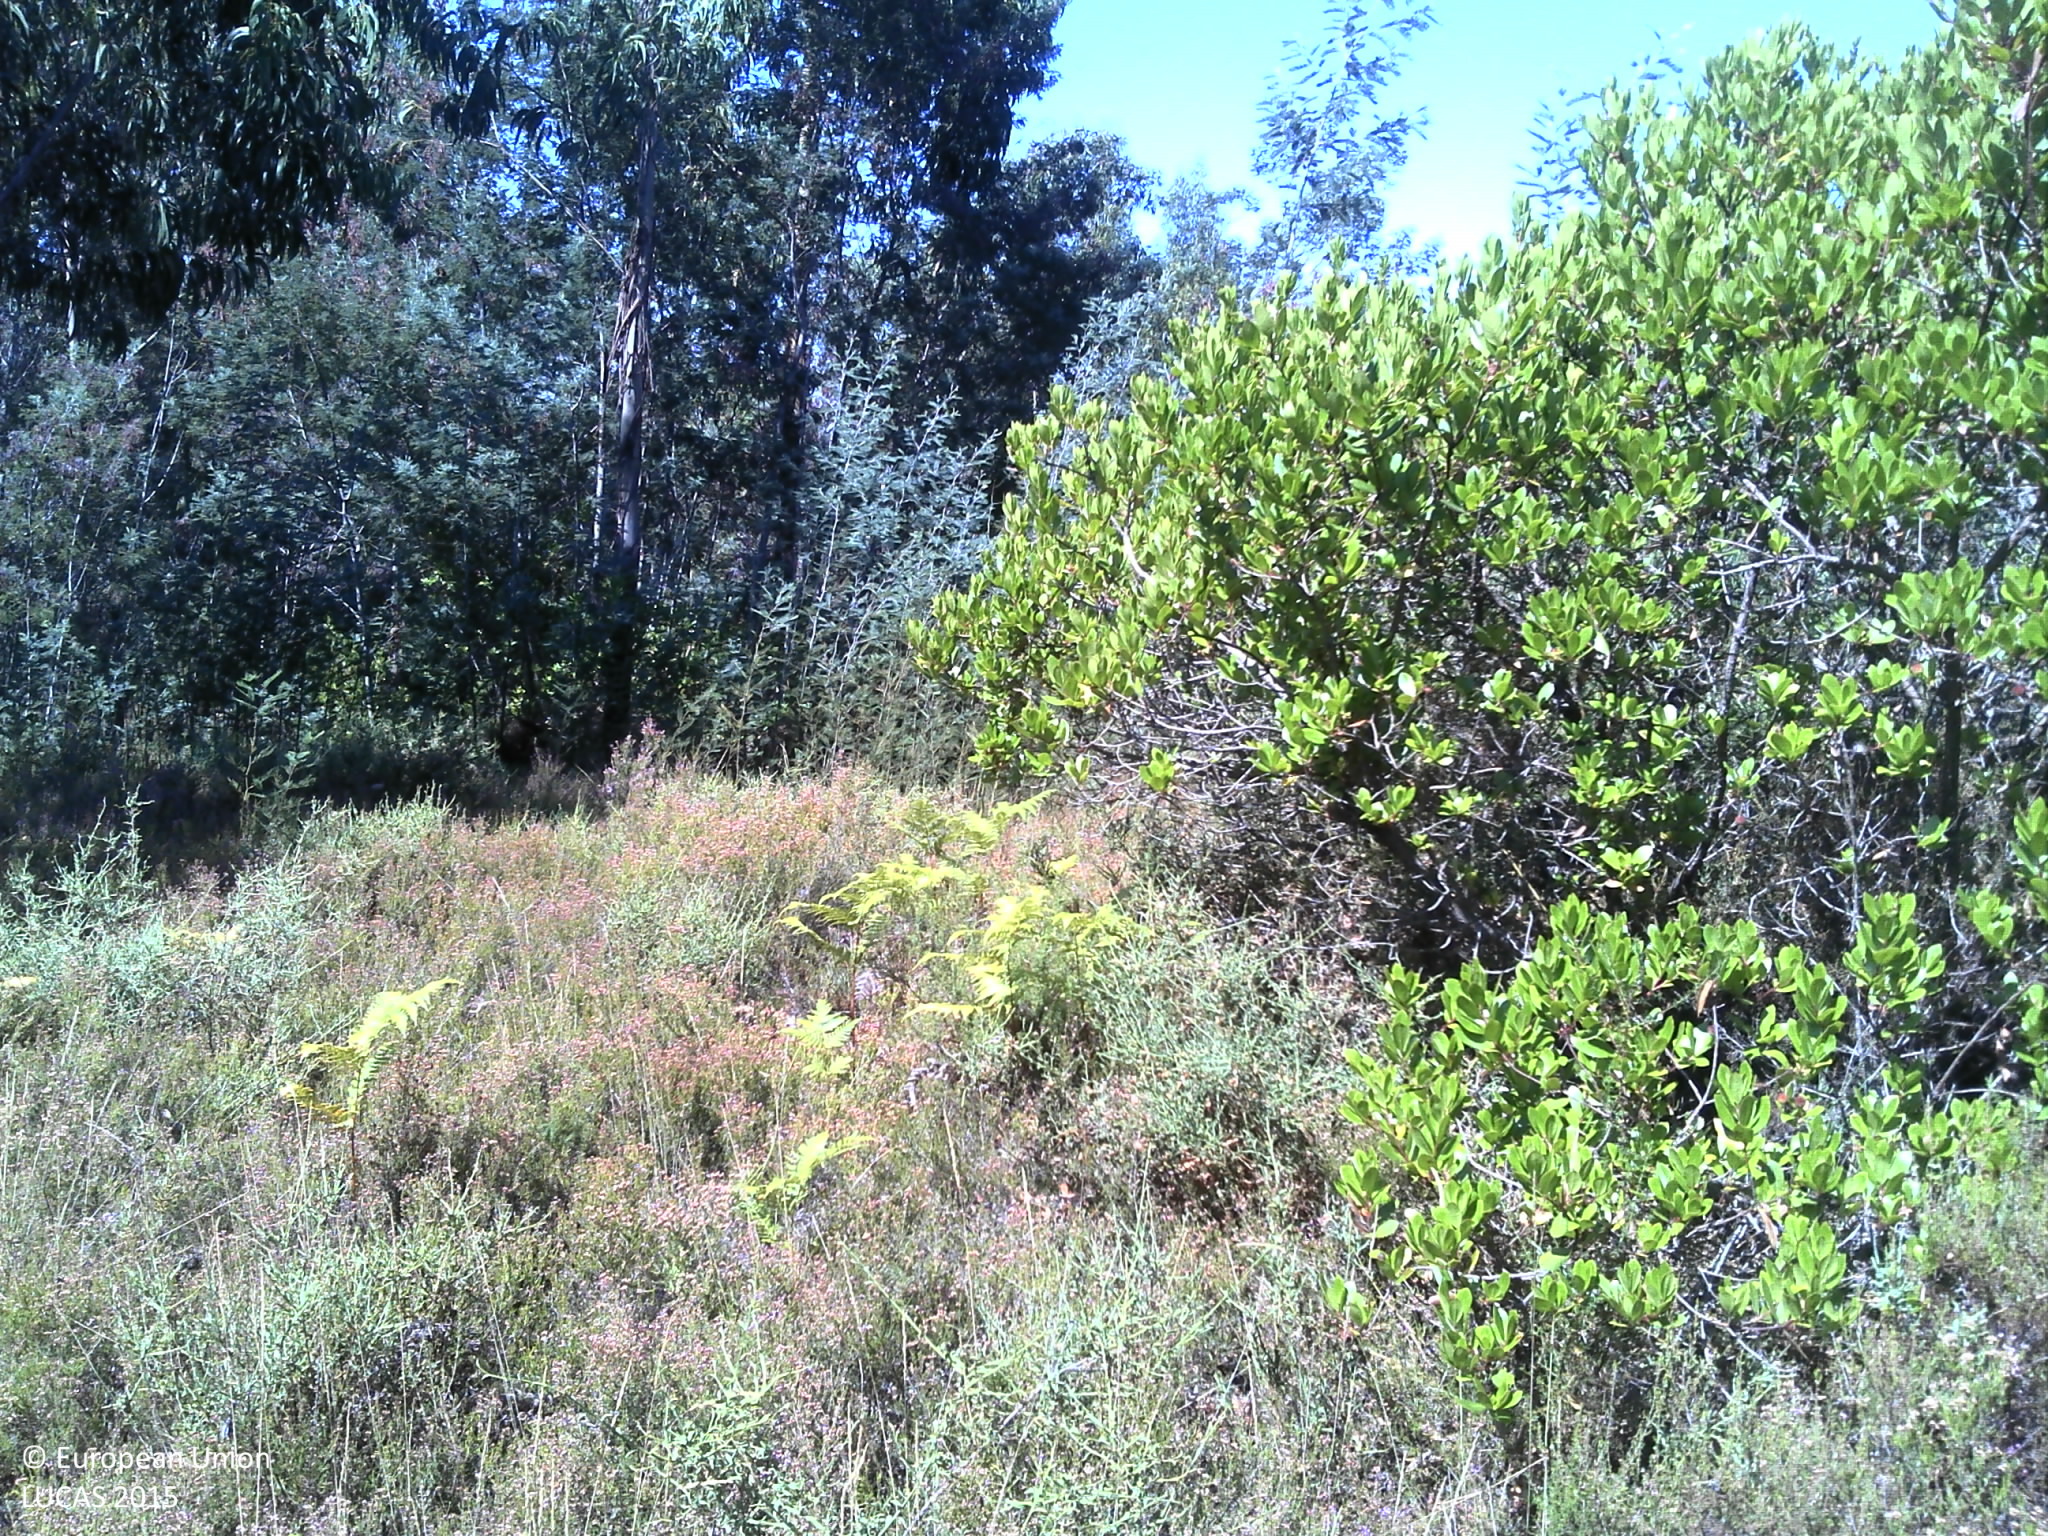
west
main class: Shrubland
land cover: Shrubland with sparse tree cover
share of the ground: > 75 %
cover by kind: shrubs 90 %, broadleaved forest trees 5 %, herbaceous plants 5 %
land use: Semi-natural and natural areas not in use
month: June
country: PT
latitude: 40.1676
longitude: -8.2426
